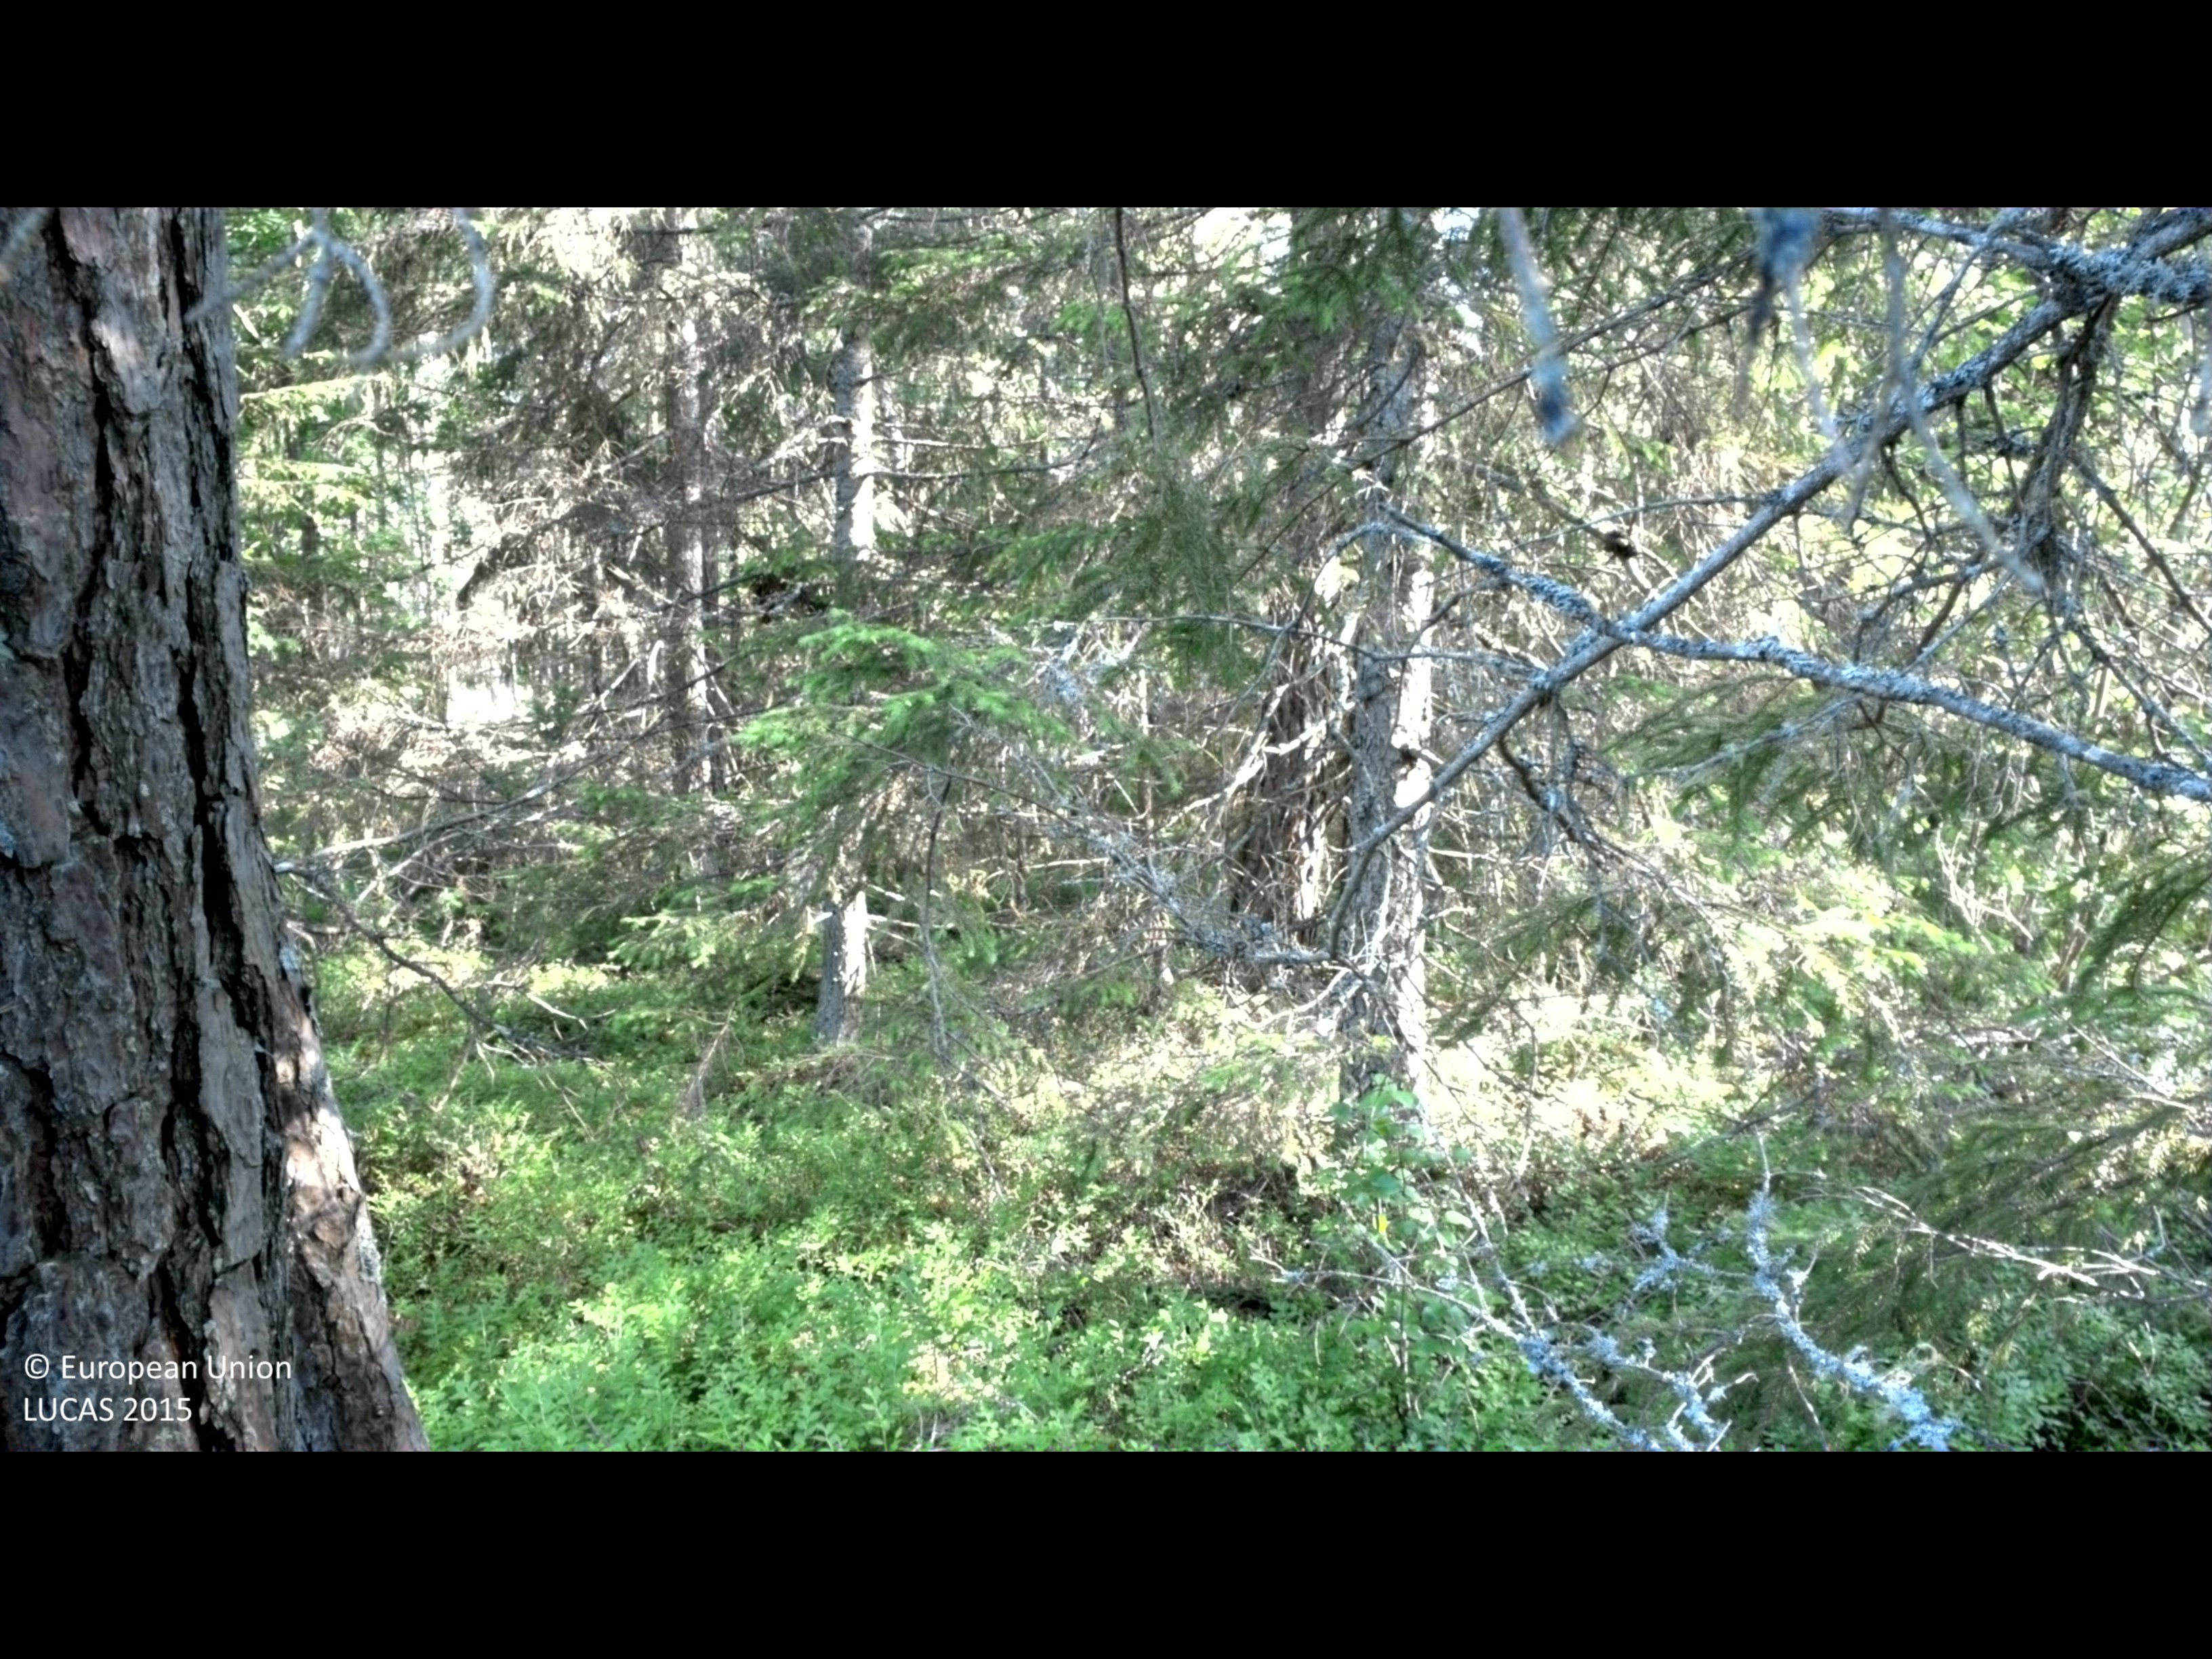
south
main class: Woodland
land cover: Pine dominated coniferous woodland
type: boreal forest
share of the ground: > 75 %
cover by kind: coniferous forest trees 65 %, broadleaved forest trees 15 %, shrubs 15 %, lichens and mosses 5 %
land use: Forestry
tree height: > 5 m
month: June
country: SE
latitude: 58.0171
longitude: 16.6845
